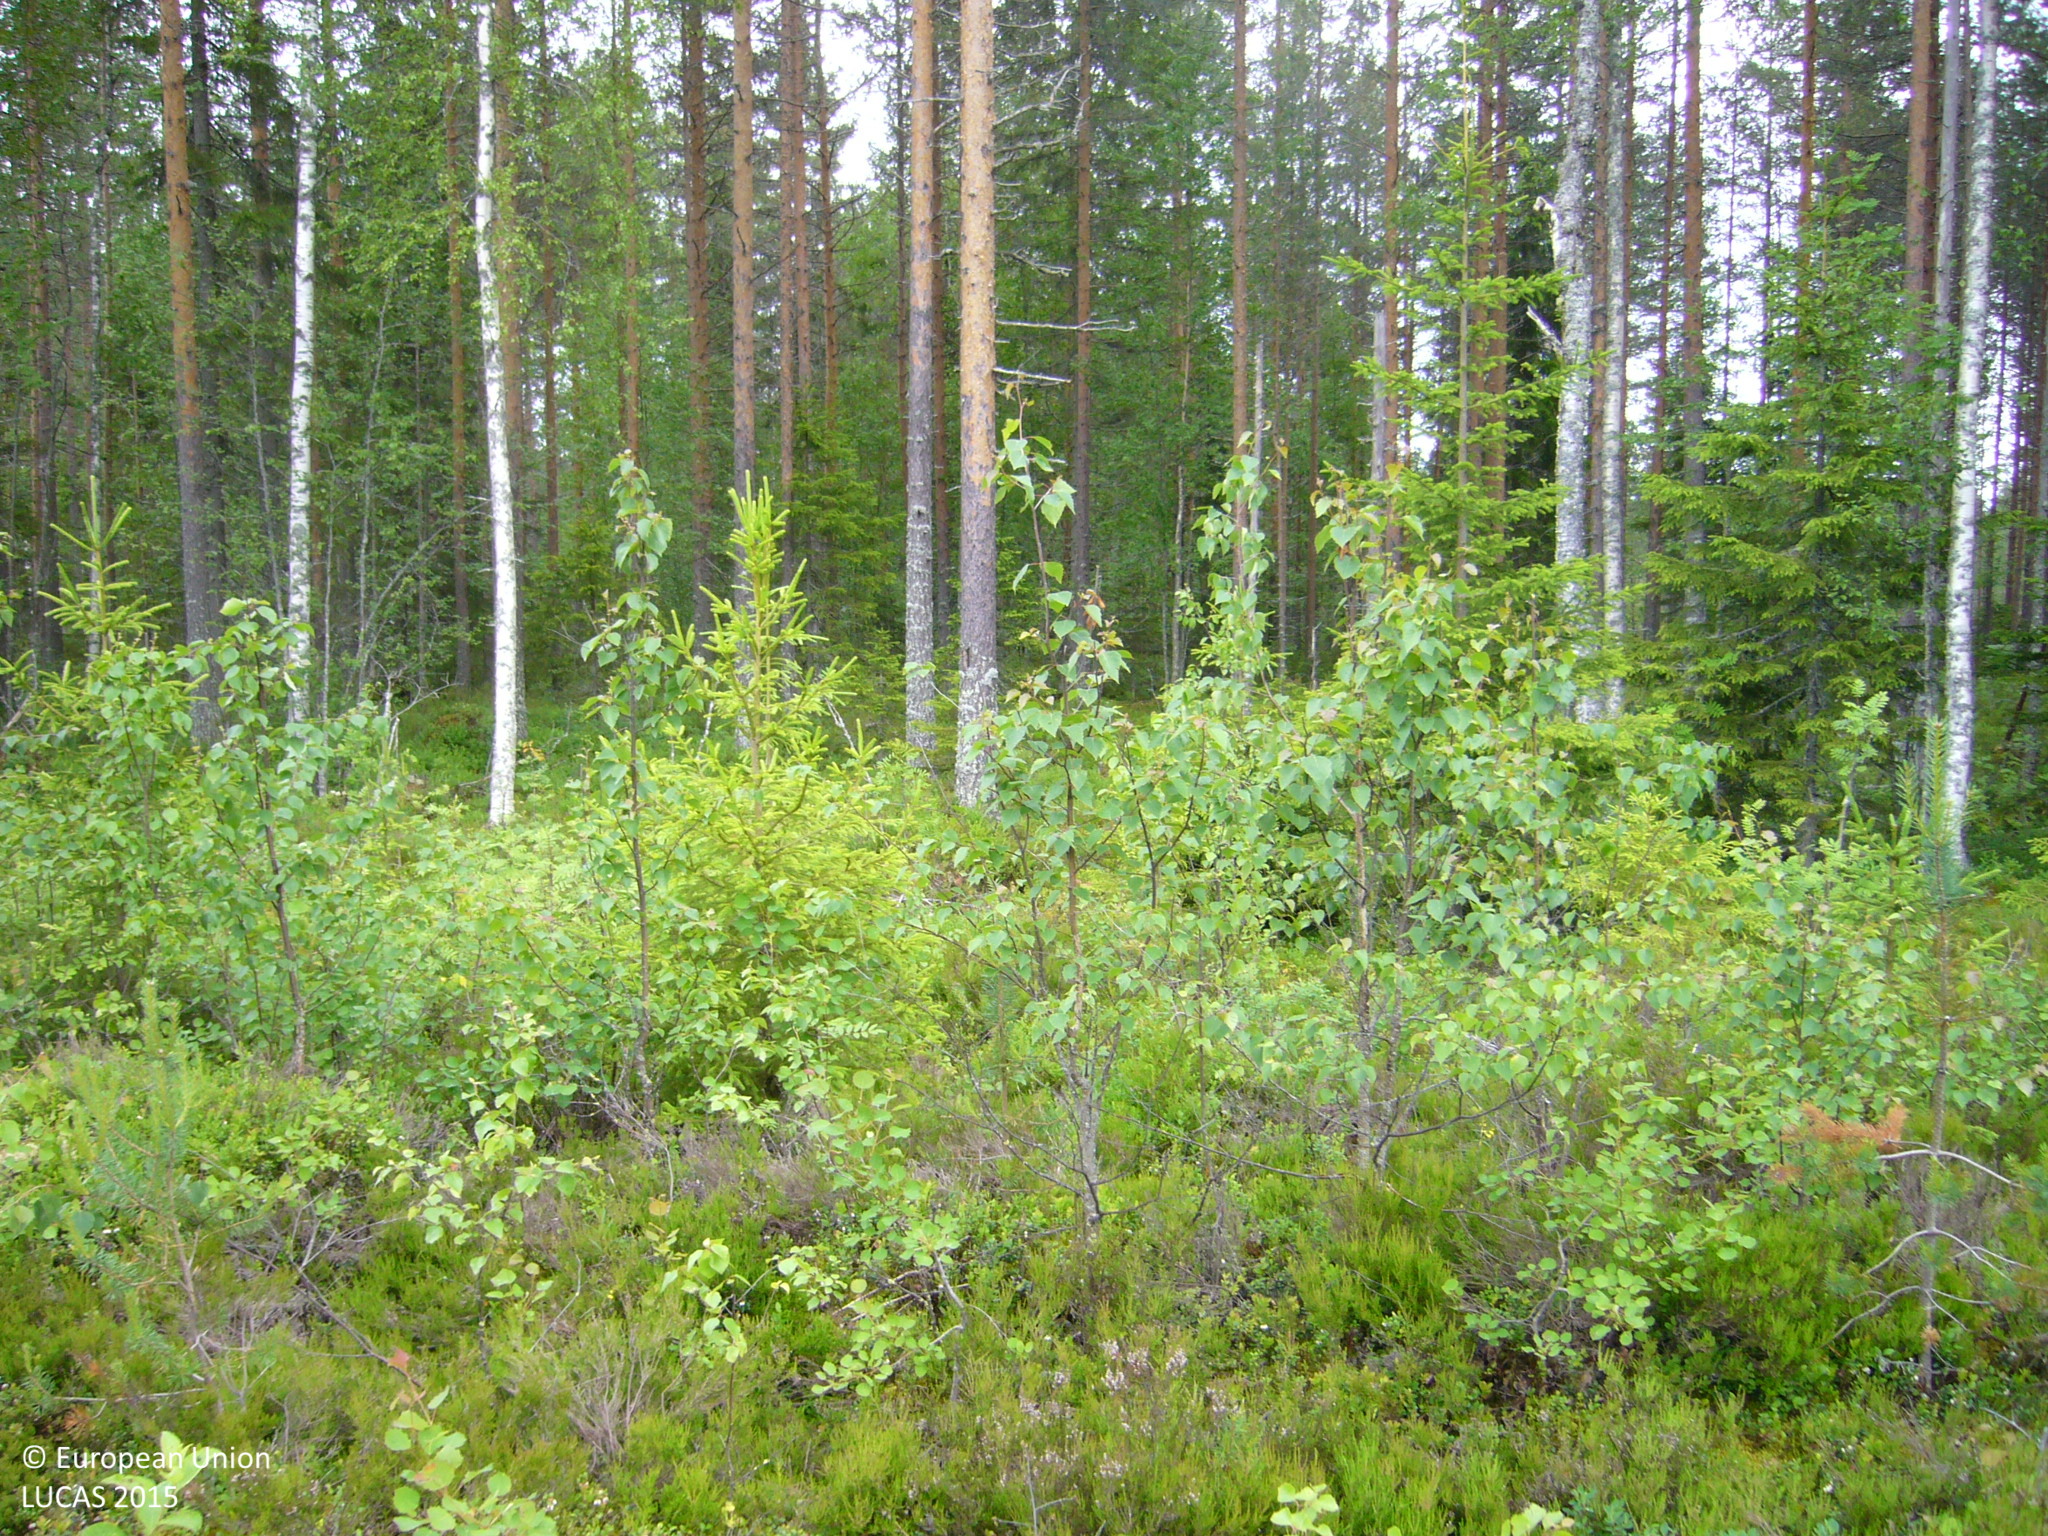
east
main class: Woodland
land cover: Pine dominated mixed woodland
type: boreal forest
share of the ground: 50 - 75 %
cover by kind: shrubs 45 %, coniferous forest trees 30 %, broadleaved forest trees 25 %
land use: Forestry
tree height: < 5 m
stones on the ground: 10 - 25 %
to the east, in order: Pine dominated mixed woodland; Other mixed woodland; Pine dominated mixed woodland; Ditches and canals; Pine dominated mixed woodland; Ditches and canals; Pine dominated mixed woodland
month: July
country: FI
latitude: 63.5831
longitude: 25.5953
